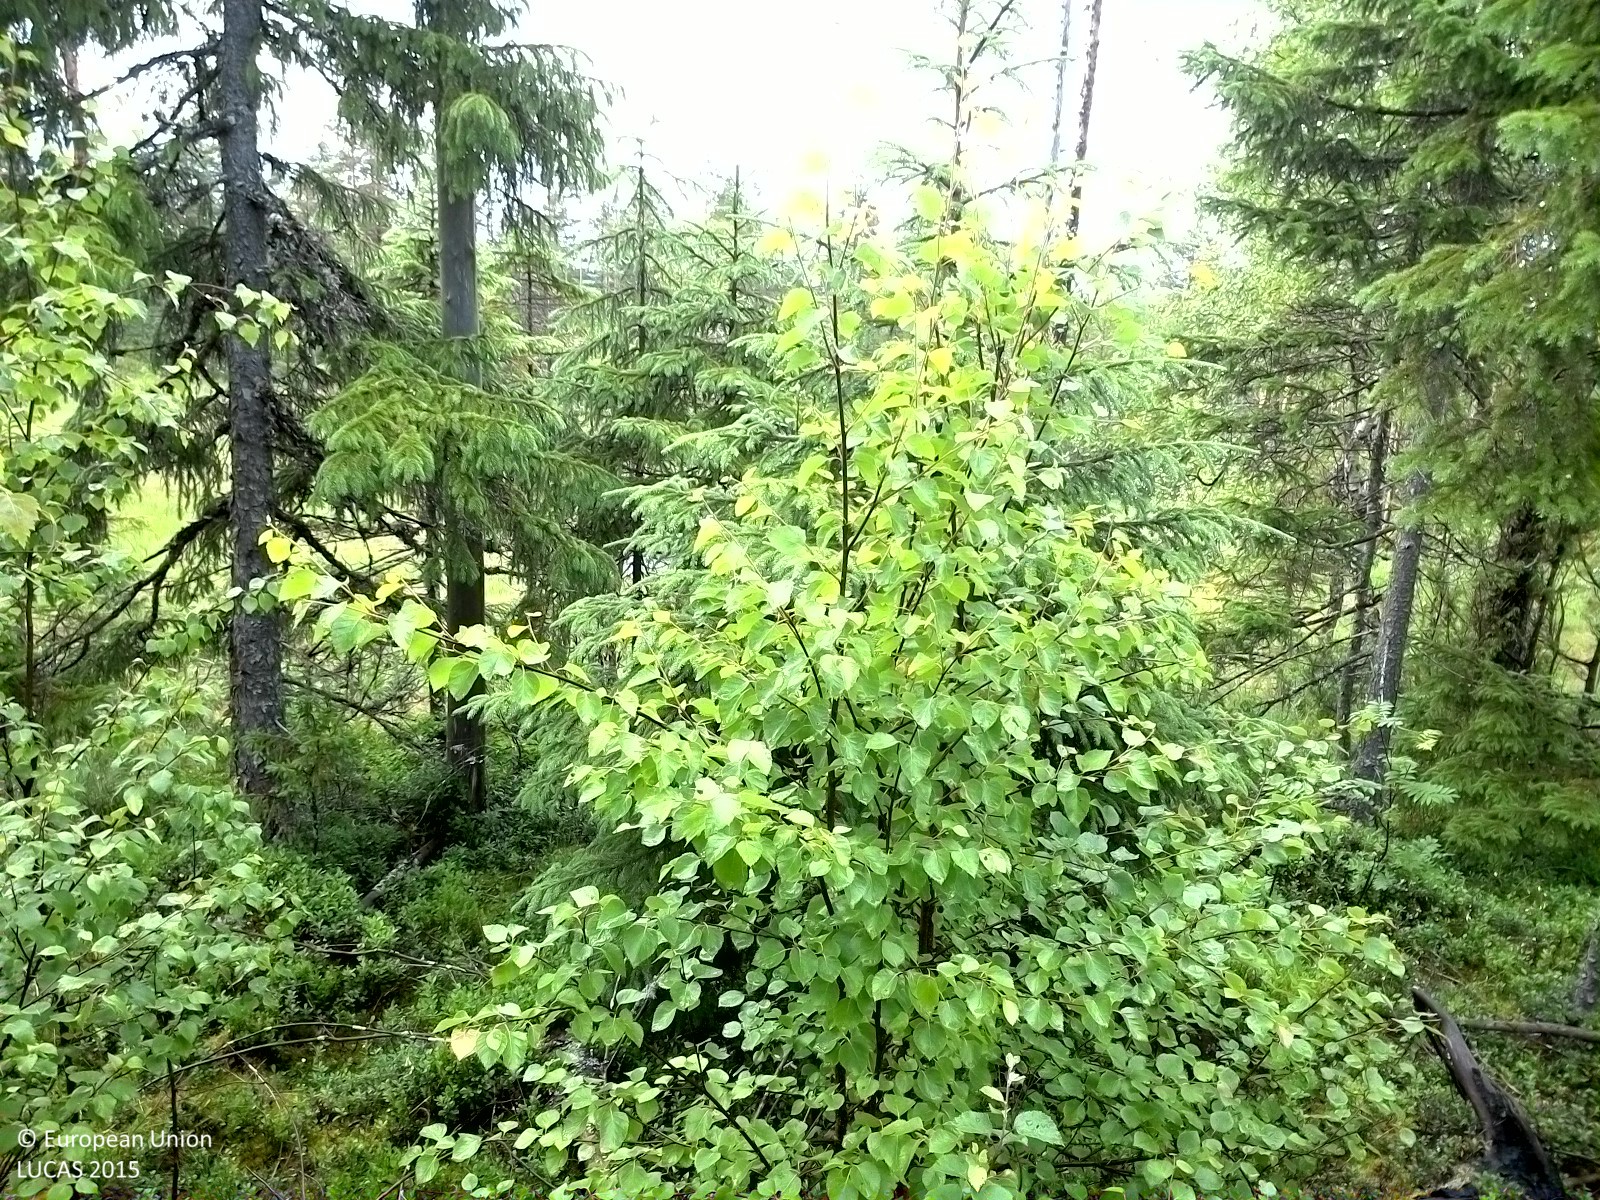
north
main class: Woodland
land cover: Broadleaved woodland
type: boreal forest
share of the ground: 50 - 75 %
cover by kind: herbaceous plants 45 %, broadleaved forest trees 40 %, coniferous forest trees 10 %, shrubs 5 %
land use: Forestry
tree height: < 5 m
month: July
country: SE
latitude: 62.6197
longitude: 17.6005
